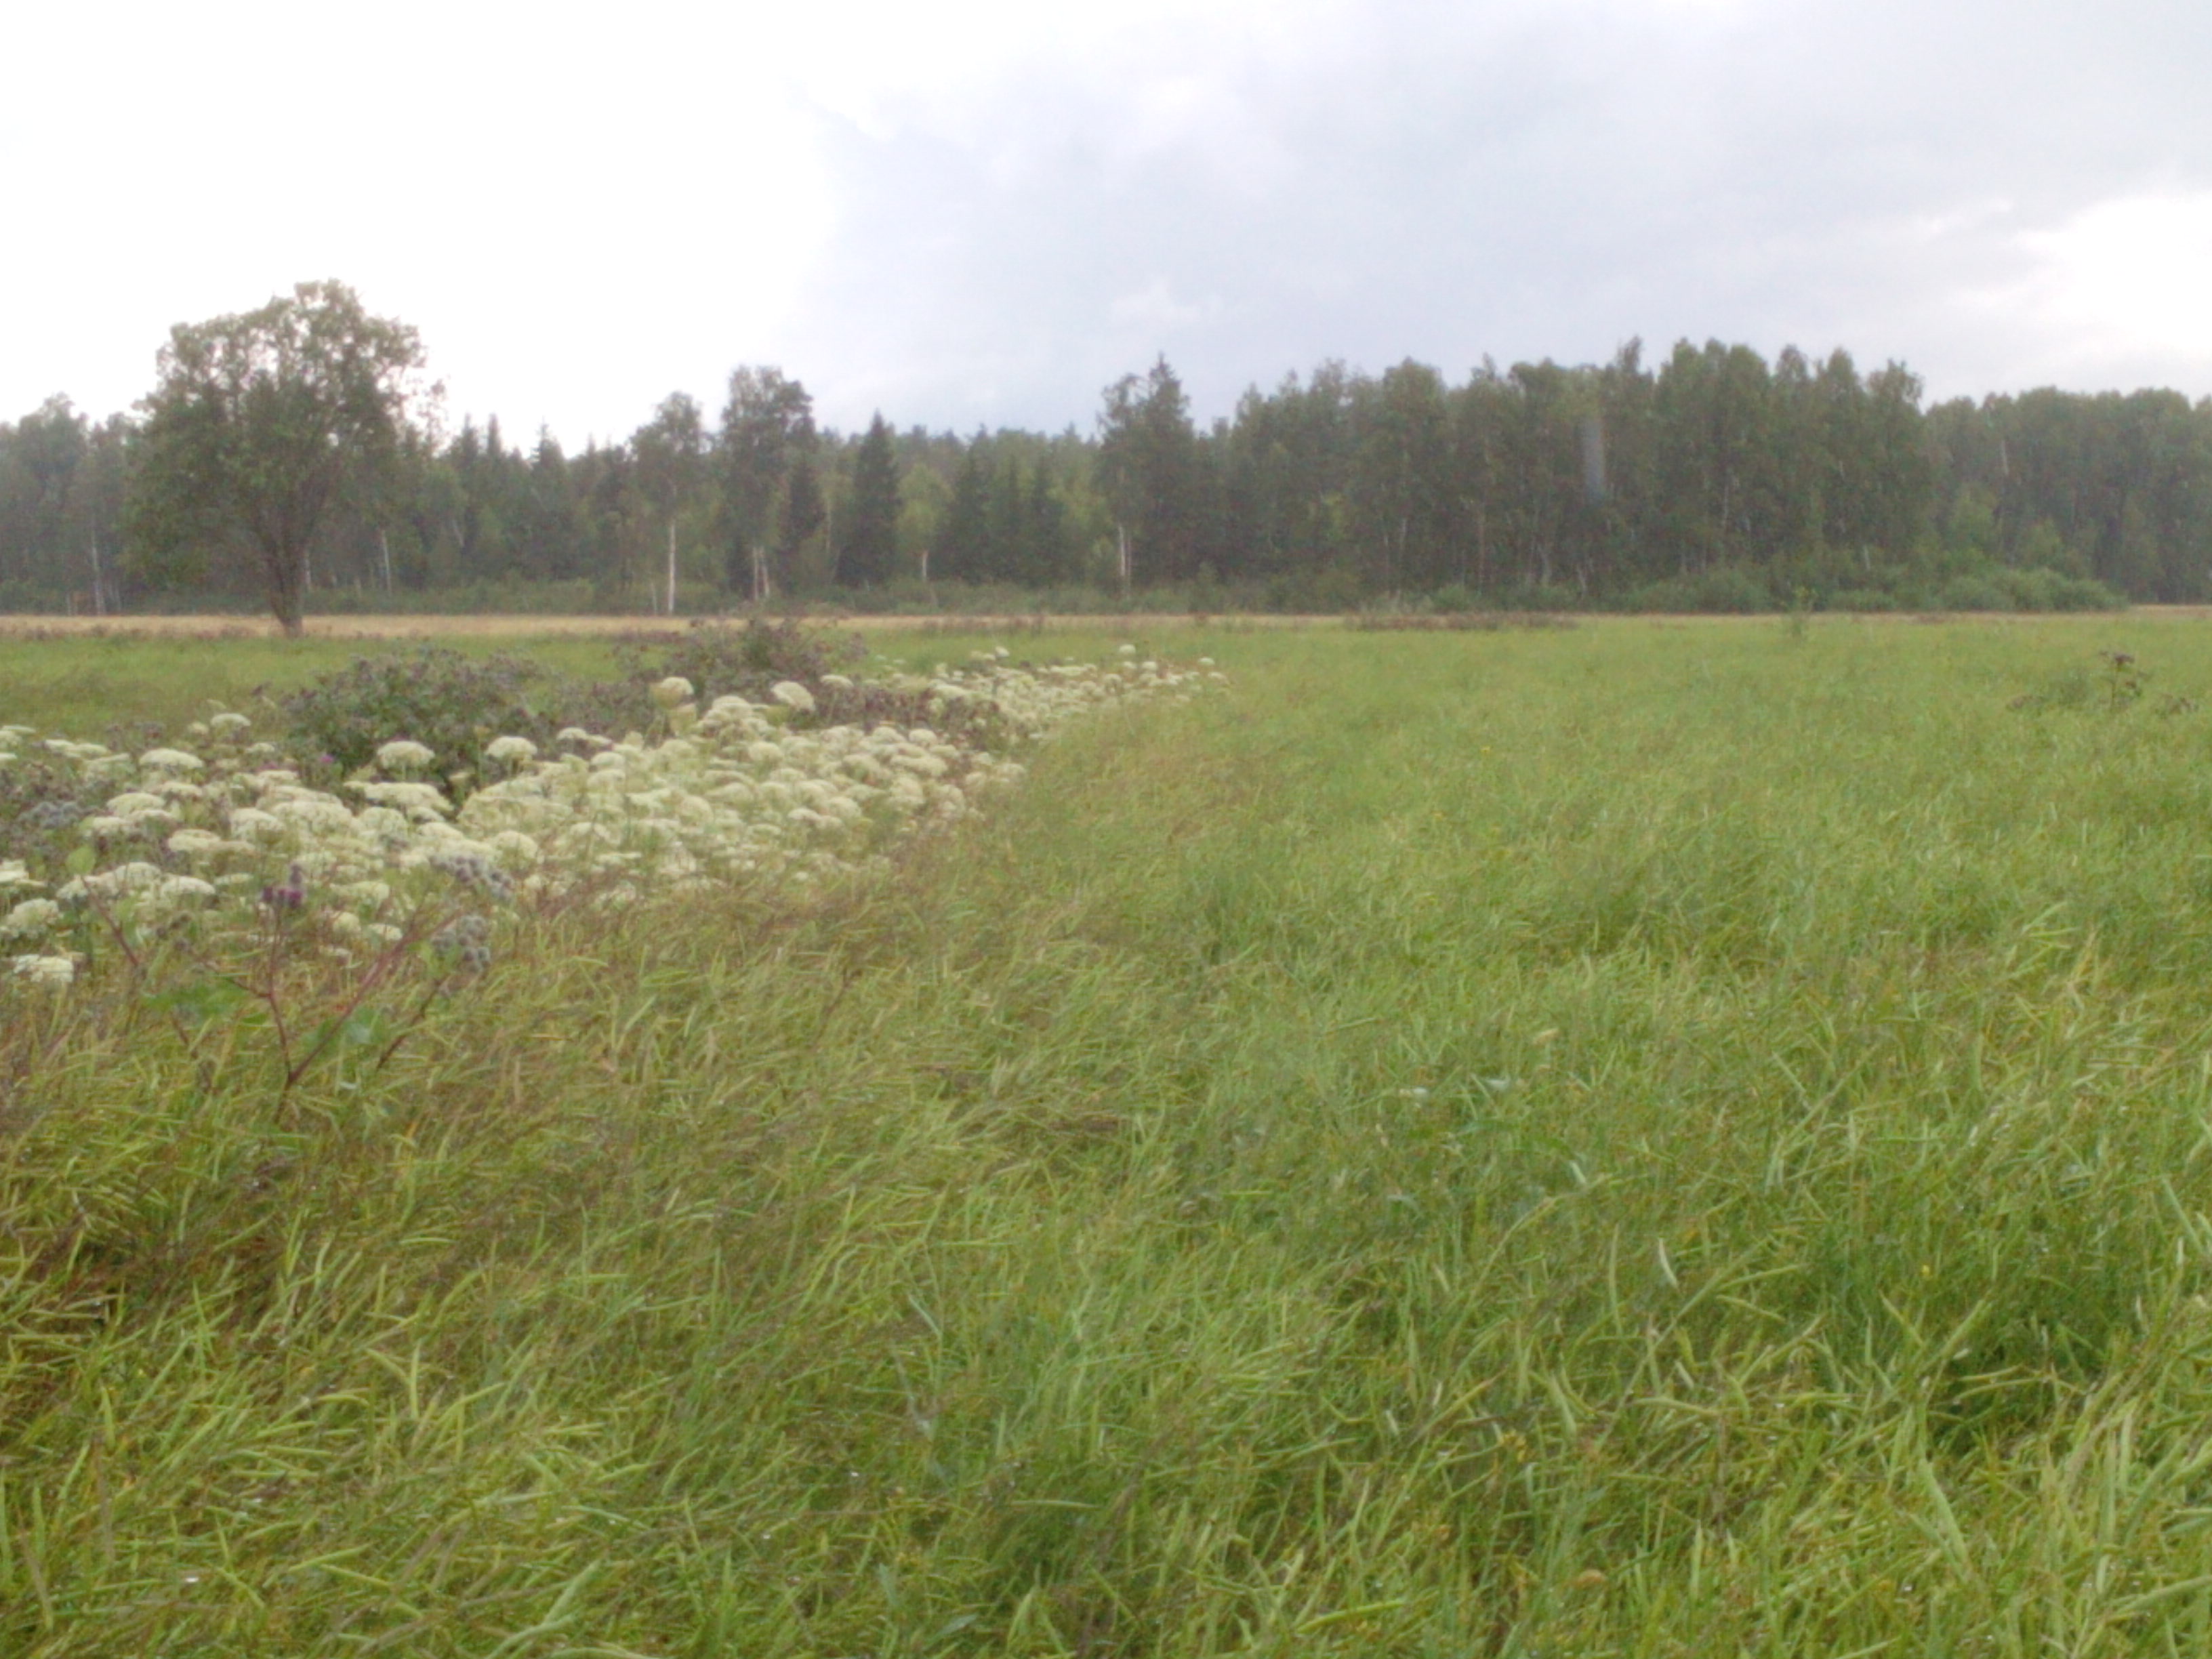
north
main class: Cropland
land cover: Rape and turnip rape
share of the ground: > 75 %
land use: Agriculture (excluding fallow land and kitchen gardens)
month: July
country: LV
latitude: 56.8950
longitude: 22.0156
